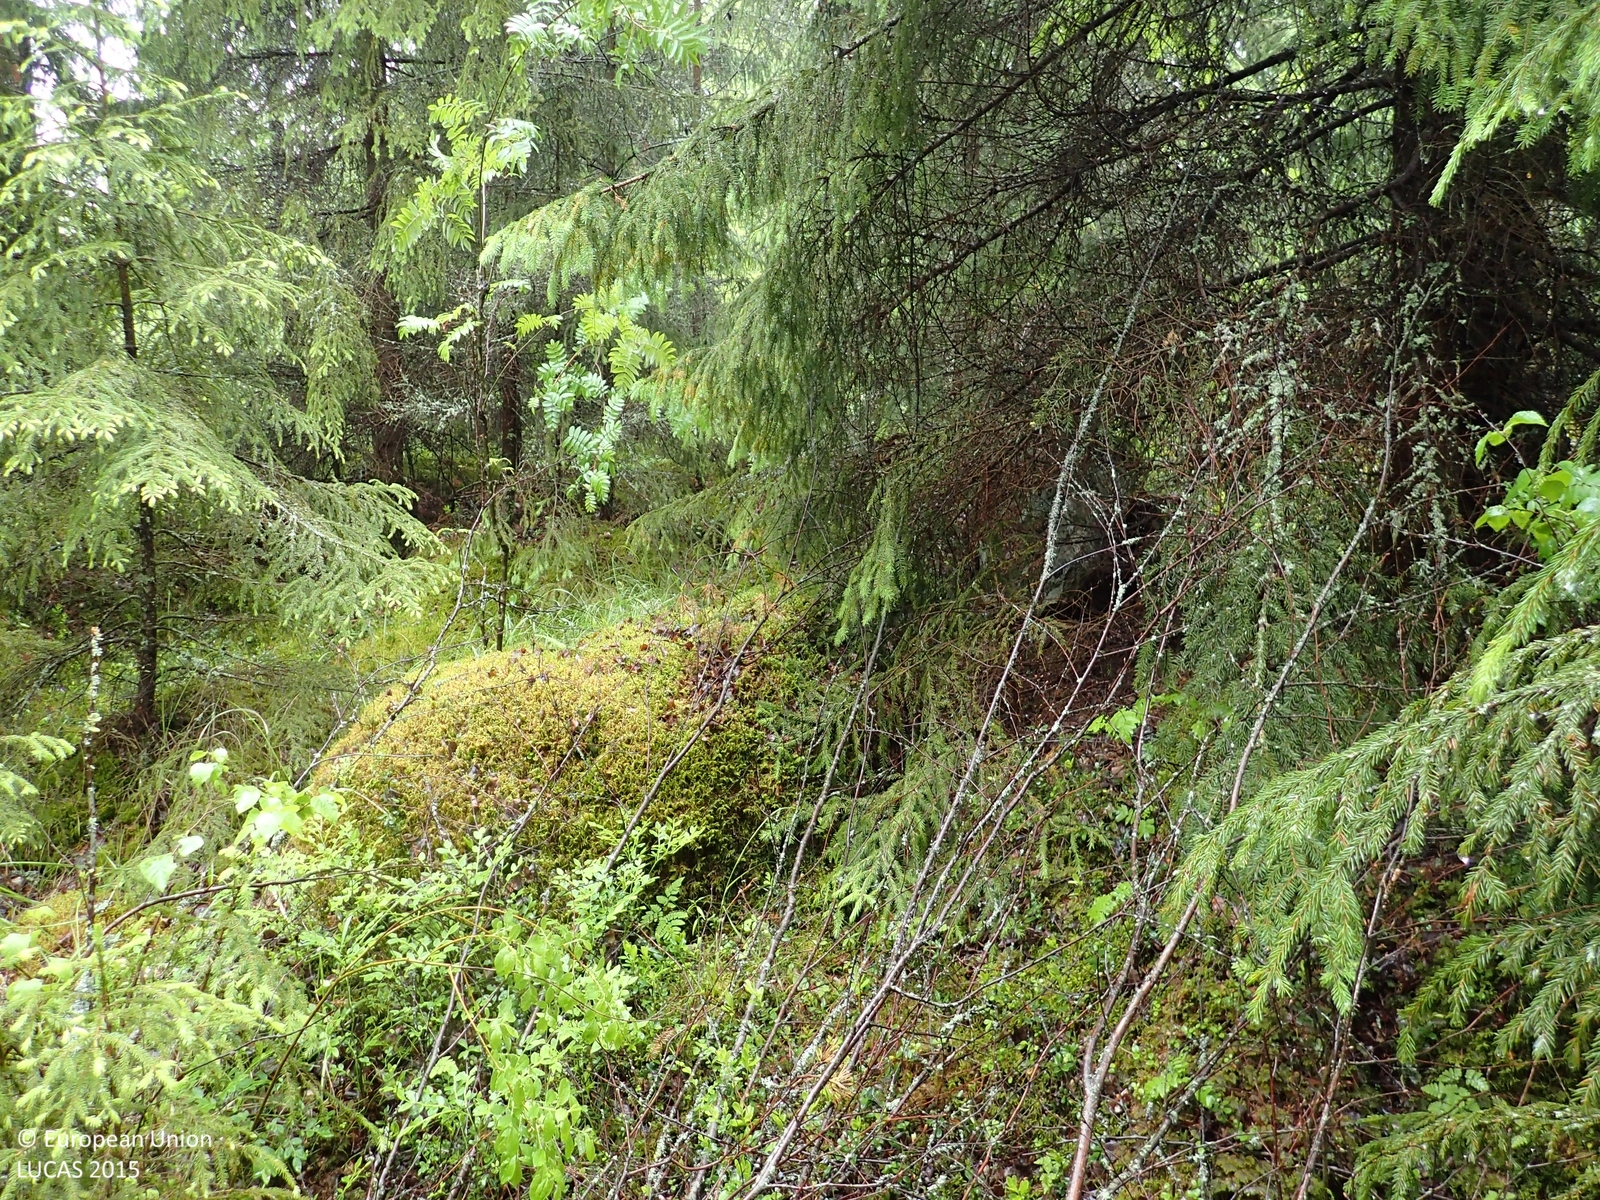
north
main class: Woodland
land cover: Spruce dominated coniferous woodland
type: boreal forest
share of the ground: 50 - 75 %
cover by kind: coniferous forest trees 60 %, shrubs 20 %, broadleaved forest trees 10 %, lichens and mosses 10 %
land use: Forestry
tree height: > 5 m
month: June
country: FI
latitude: 62.1696
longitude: 21.5086
